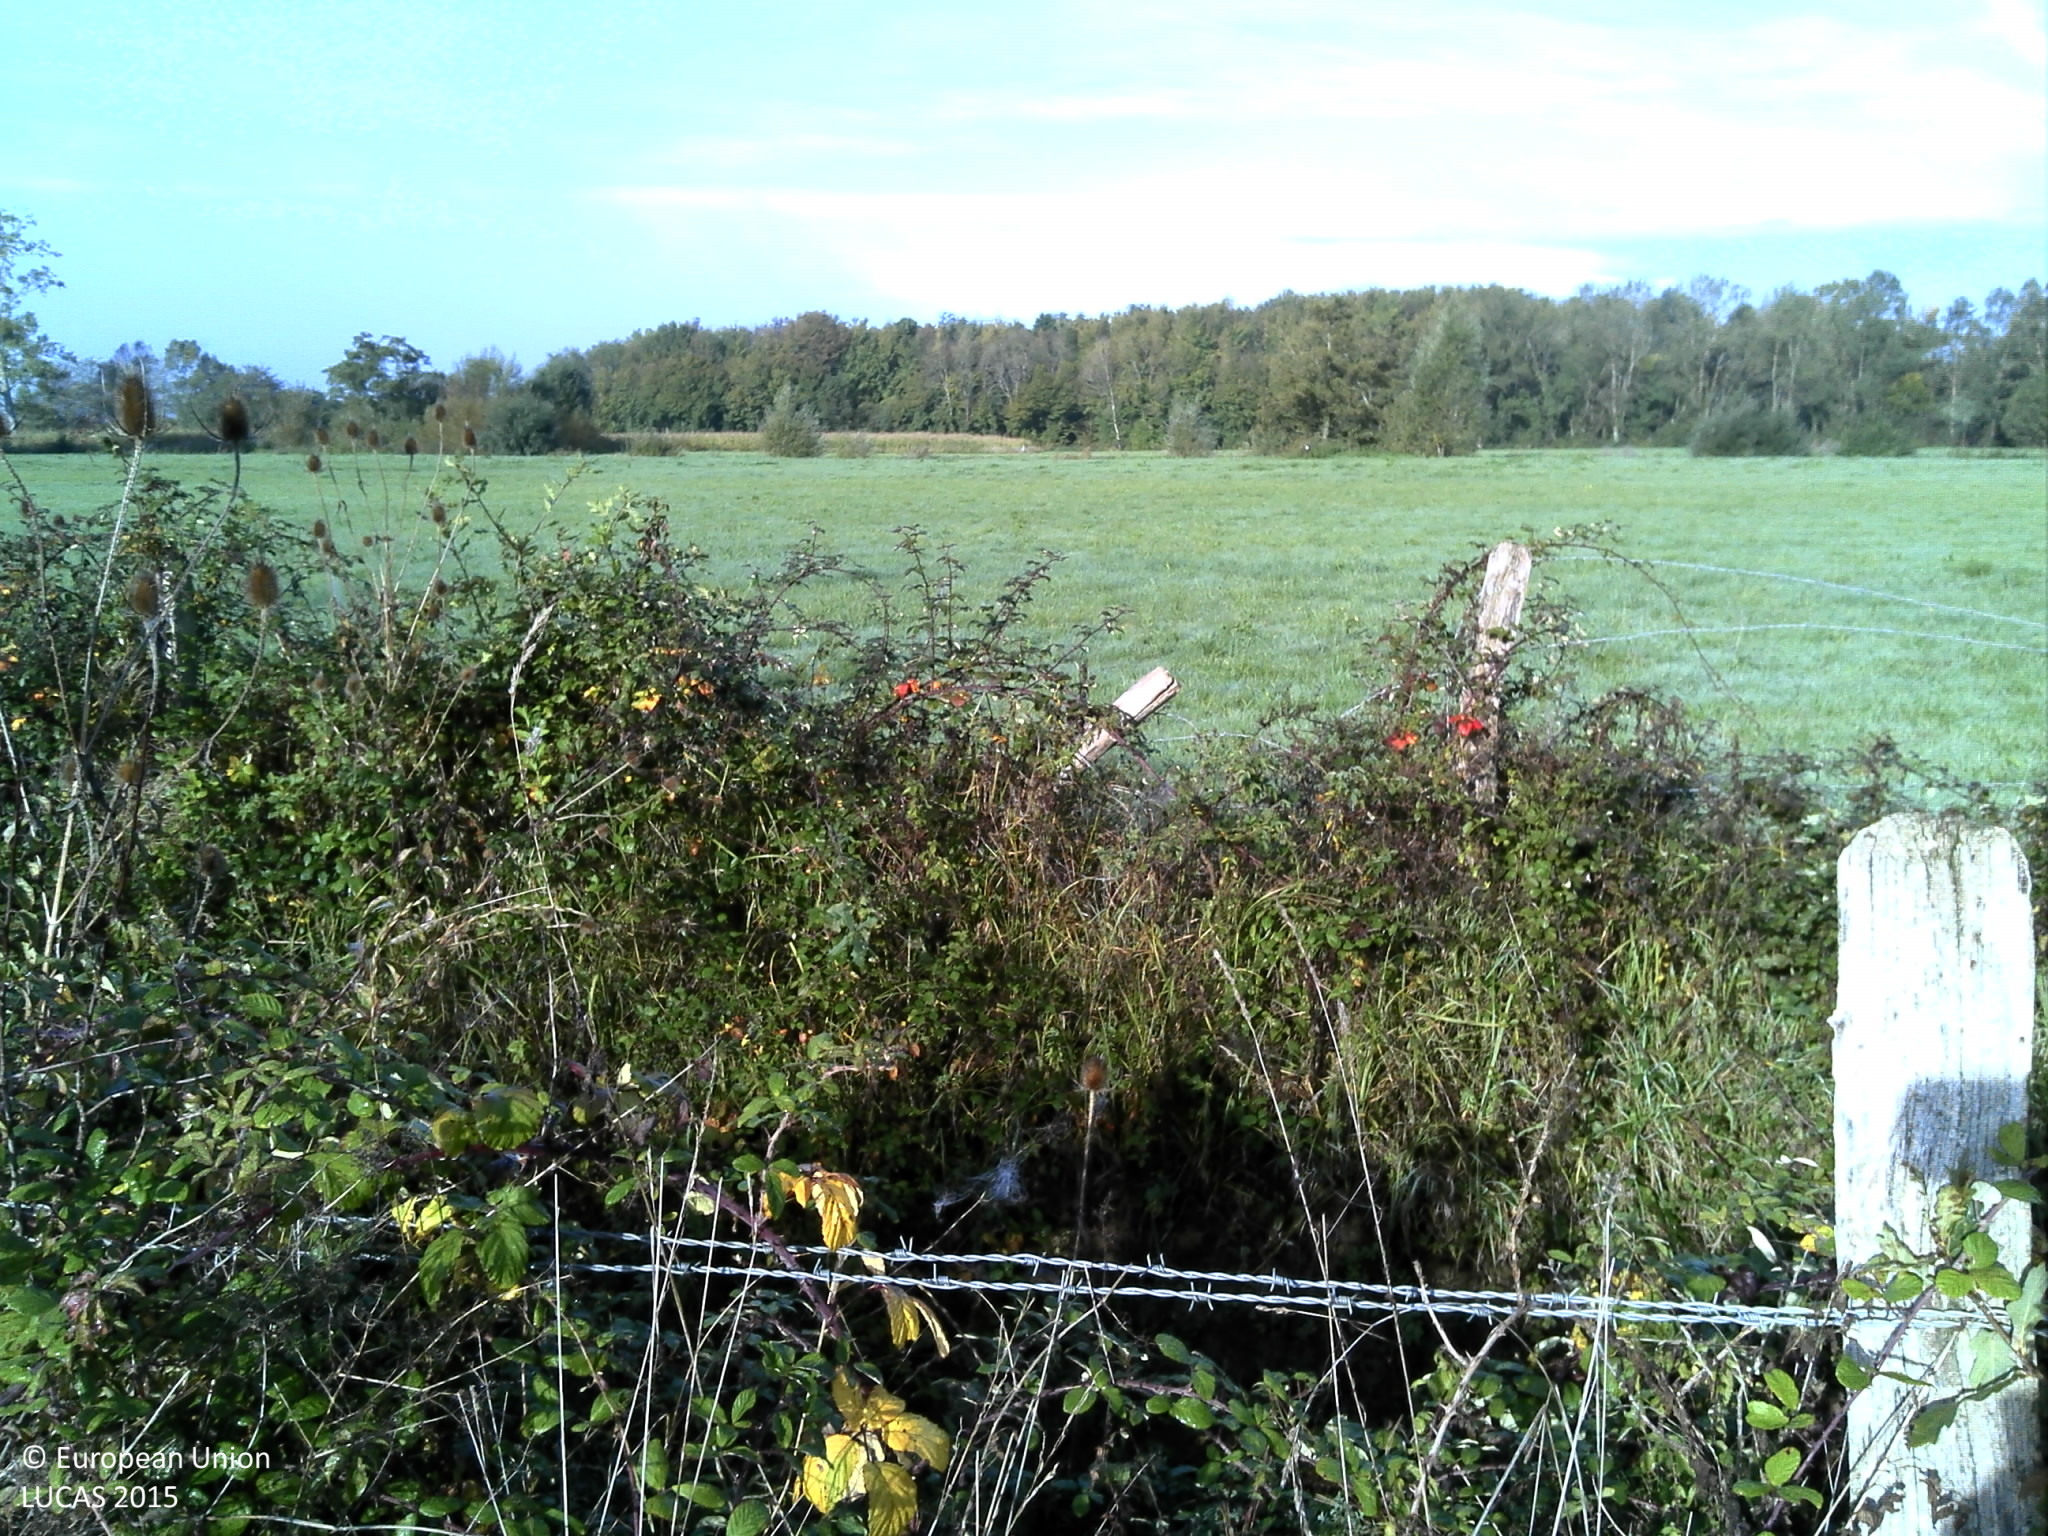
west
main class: Grassland
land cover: Grassland without tree/shrub cover
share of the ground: > 75 %
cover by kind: herbaceous plants 100 %
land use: Agriculture (excluding fallow land and kitchen gardens)
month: October
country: FR
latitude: 46.5926
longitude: 5.3426
